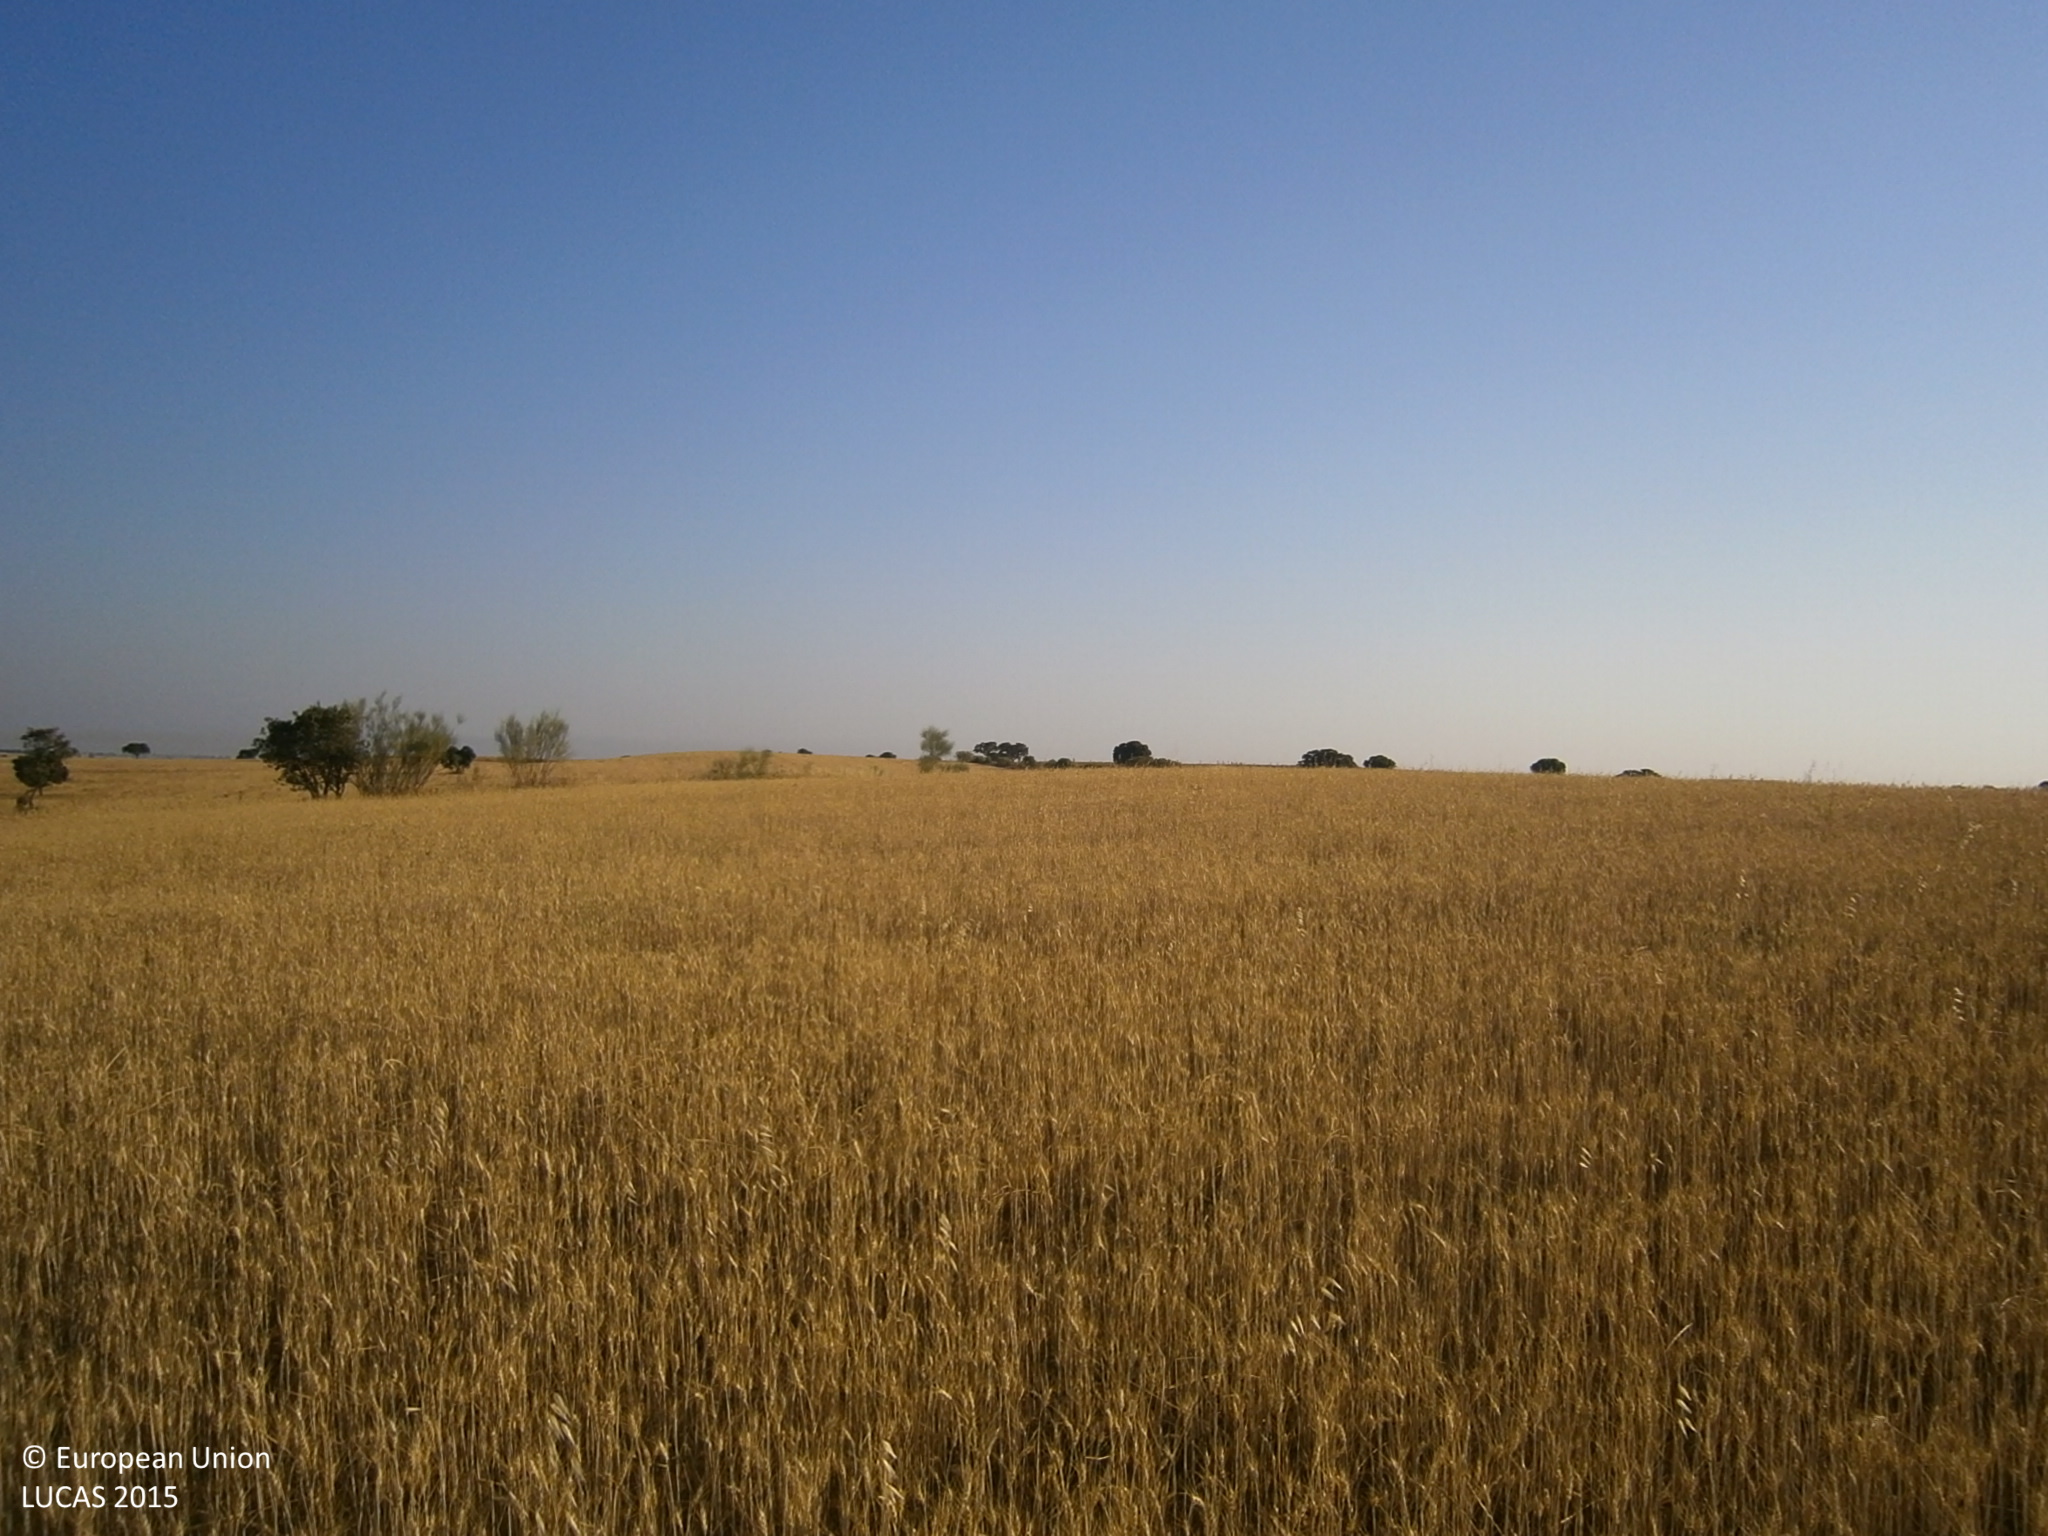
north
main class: Cropland
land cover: Durum wheat
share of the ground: > 75 %
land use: Agriculture (excluding fallow land and kitchen gardens)
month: June
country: ES
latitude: 38.7369
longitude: -6.7788
